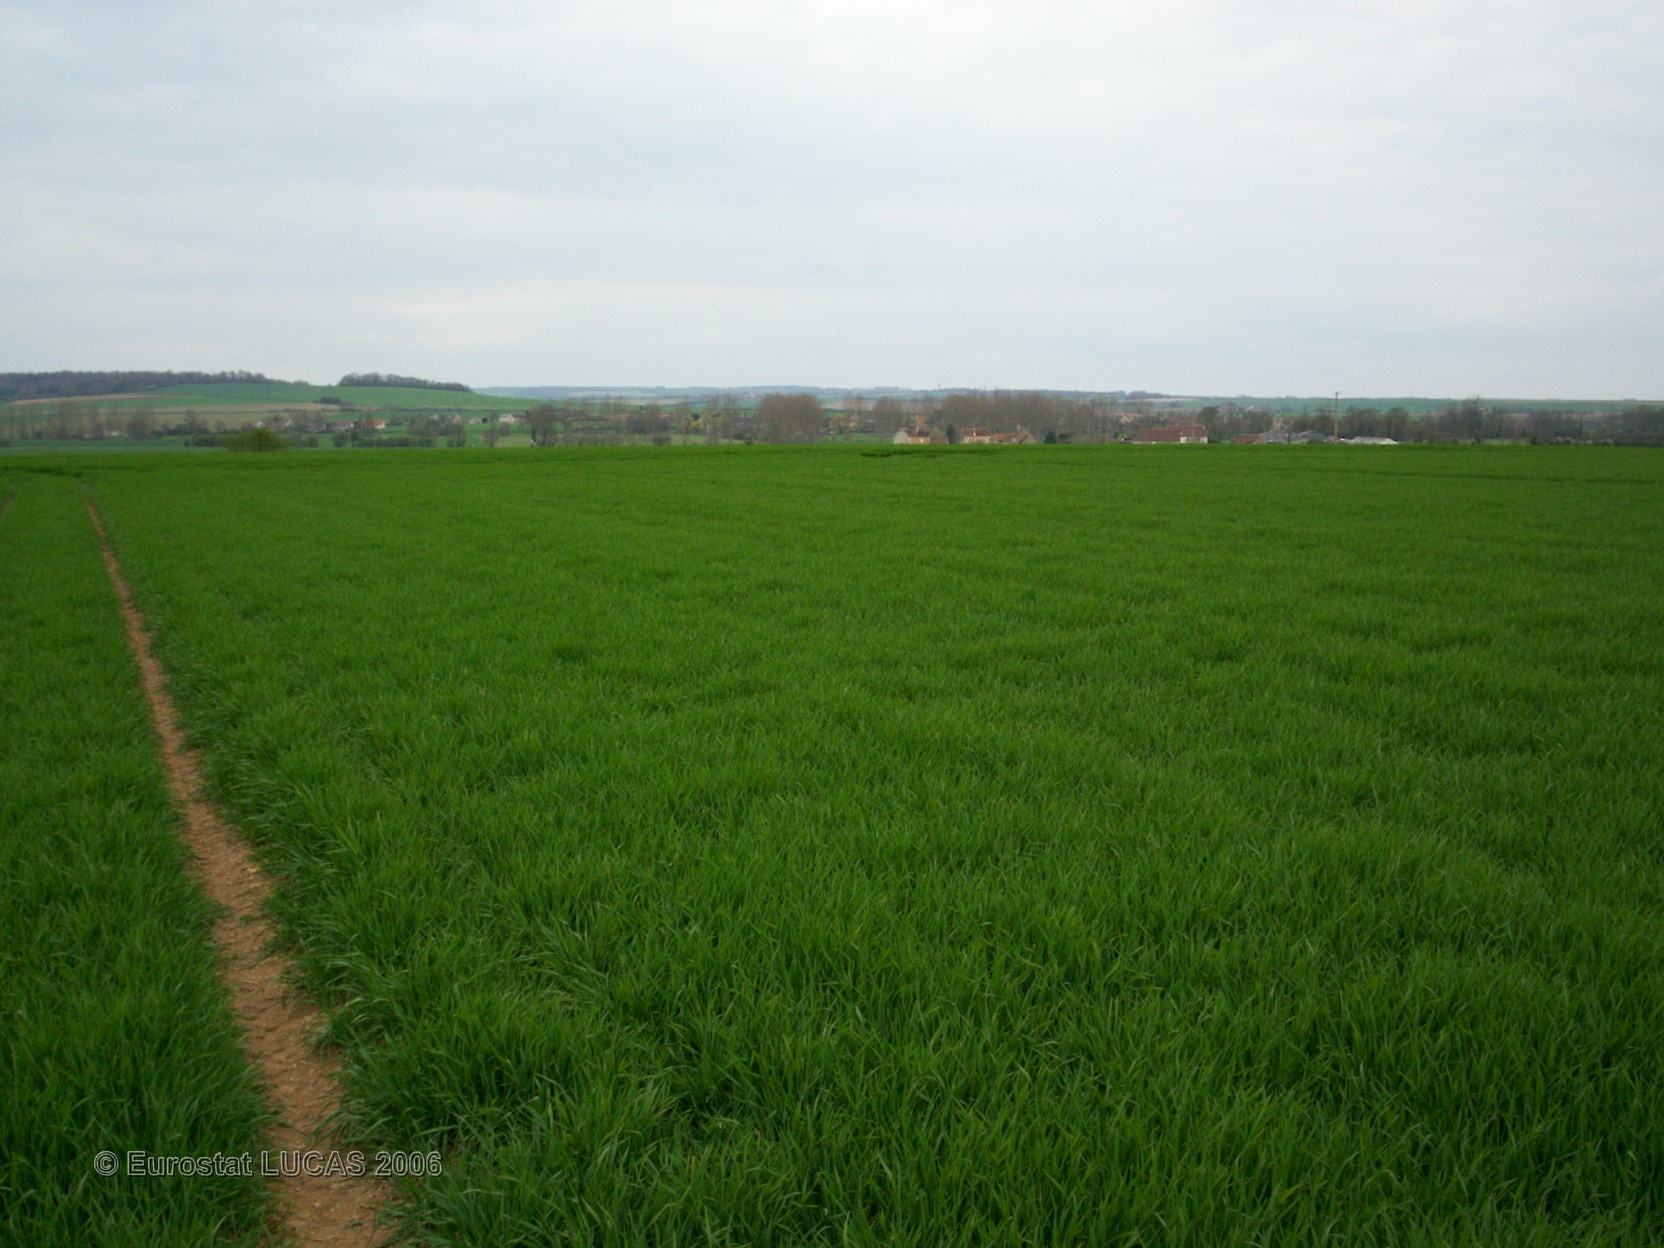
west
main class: Cropland
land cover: Barley
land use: Agriculture (excluding fallow land and kitchen gardens)
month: April
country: FR
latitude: 48.9579
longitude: -0.0695
